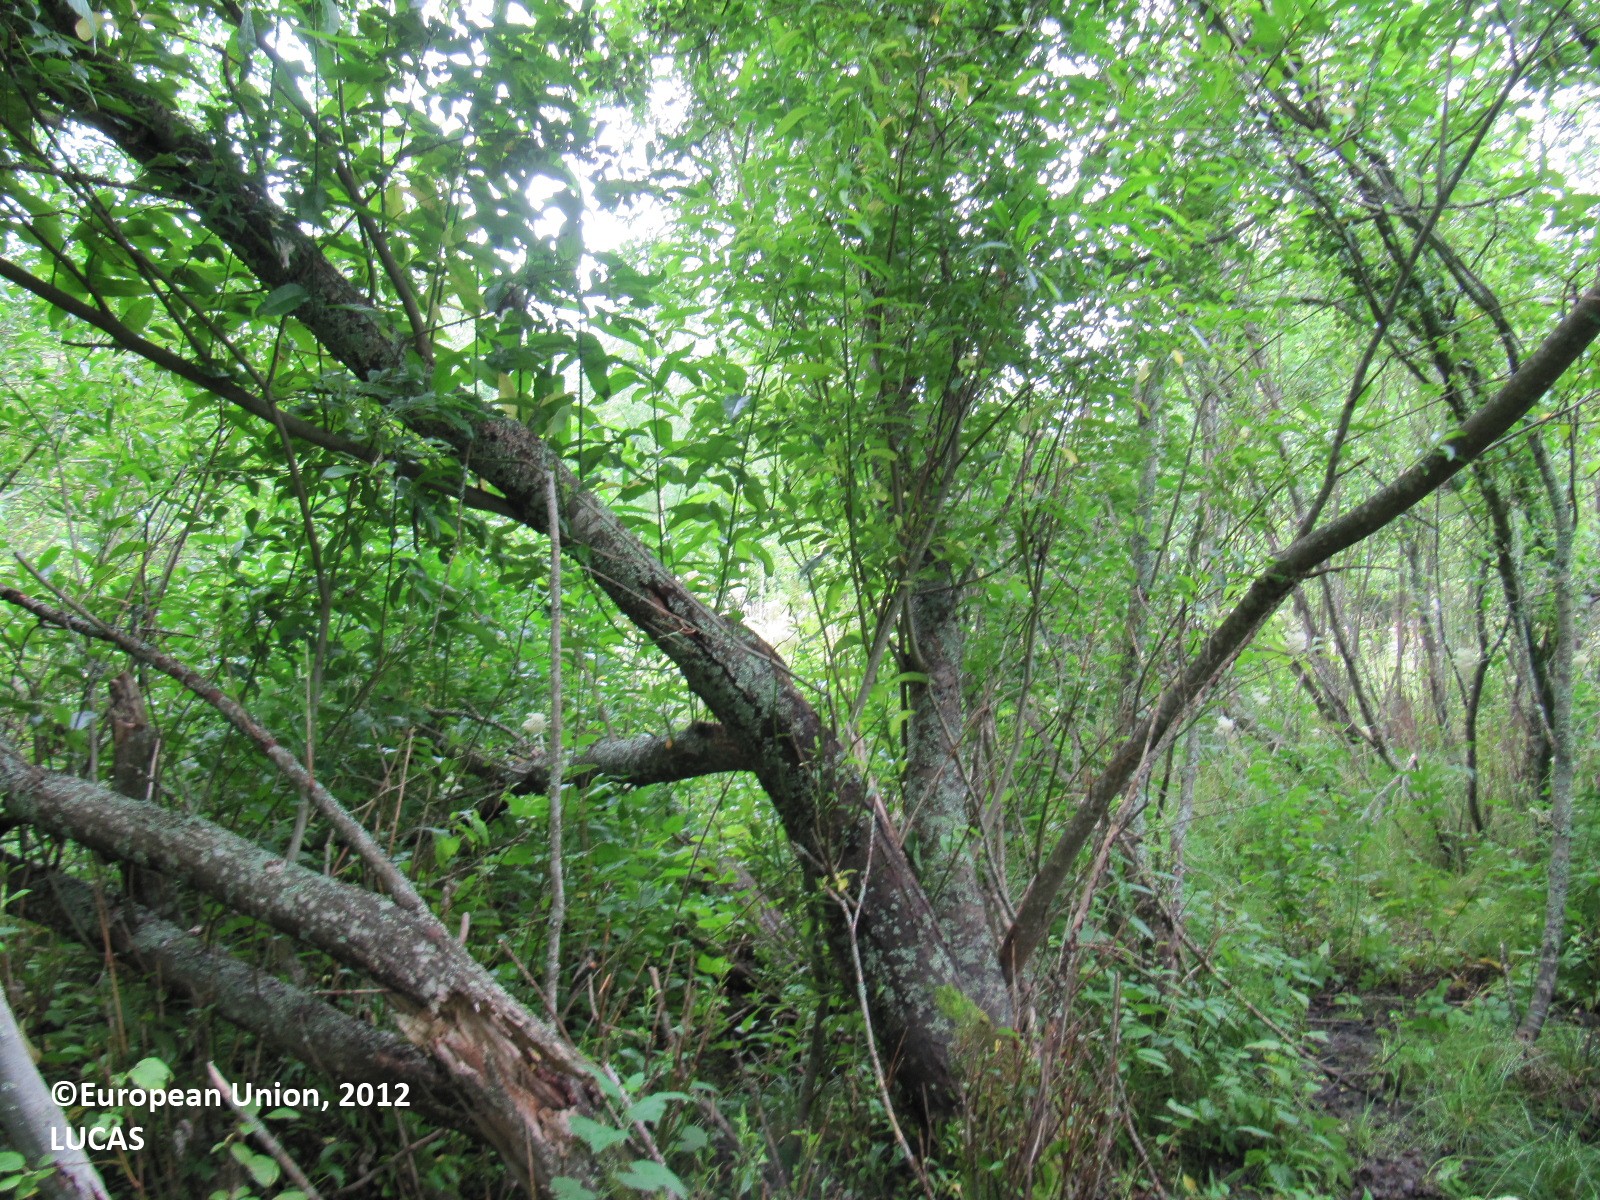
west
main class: Woodland
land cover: Broadleaved woodland
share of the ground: > 75 %
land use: Forestry
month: July
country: FI
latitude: 60.3821
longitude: 23.9363
